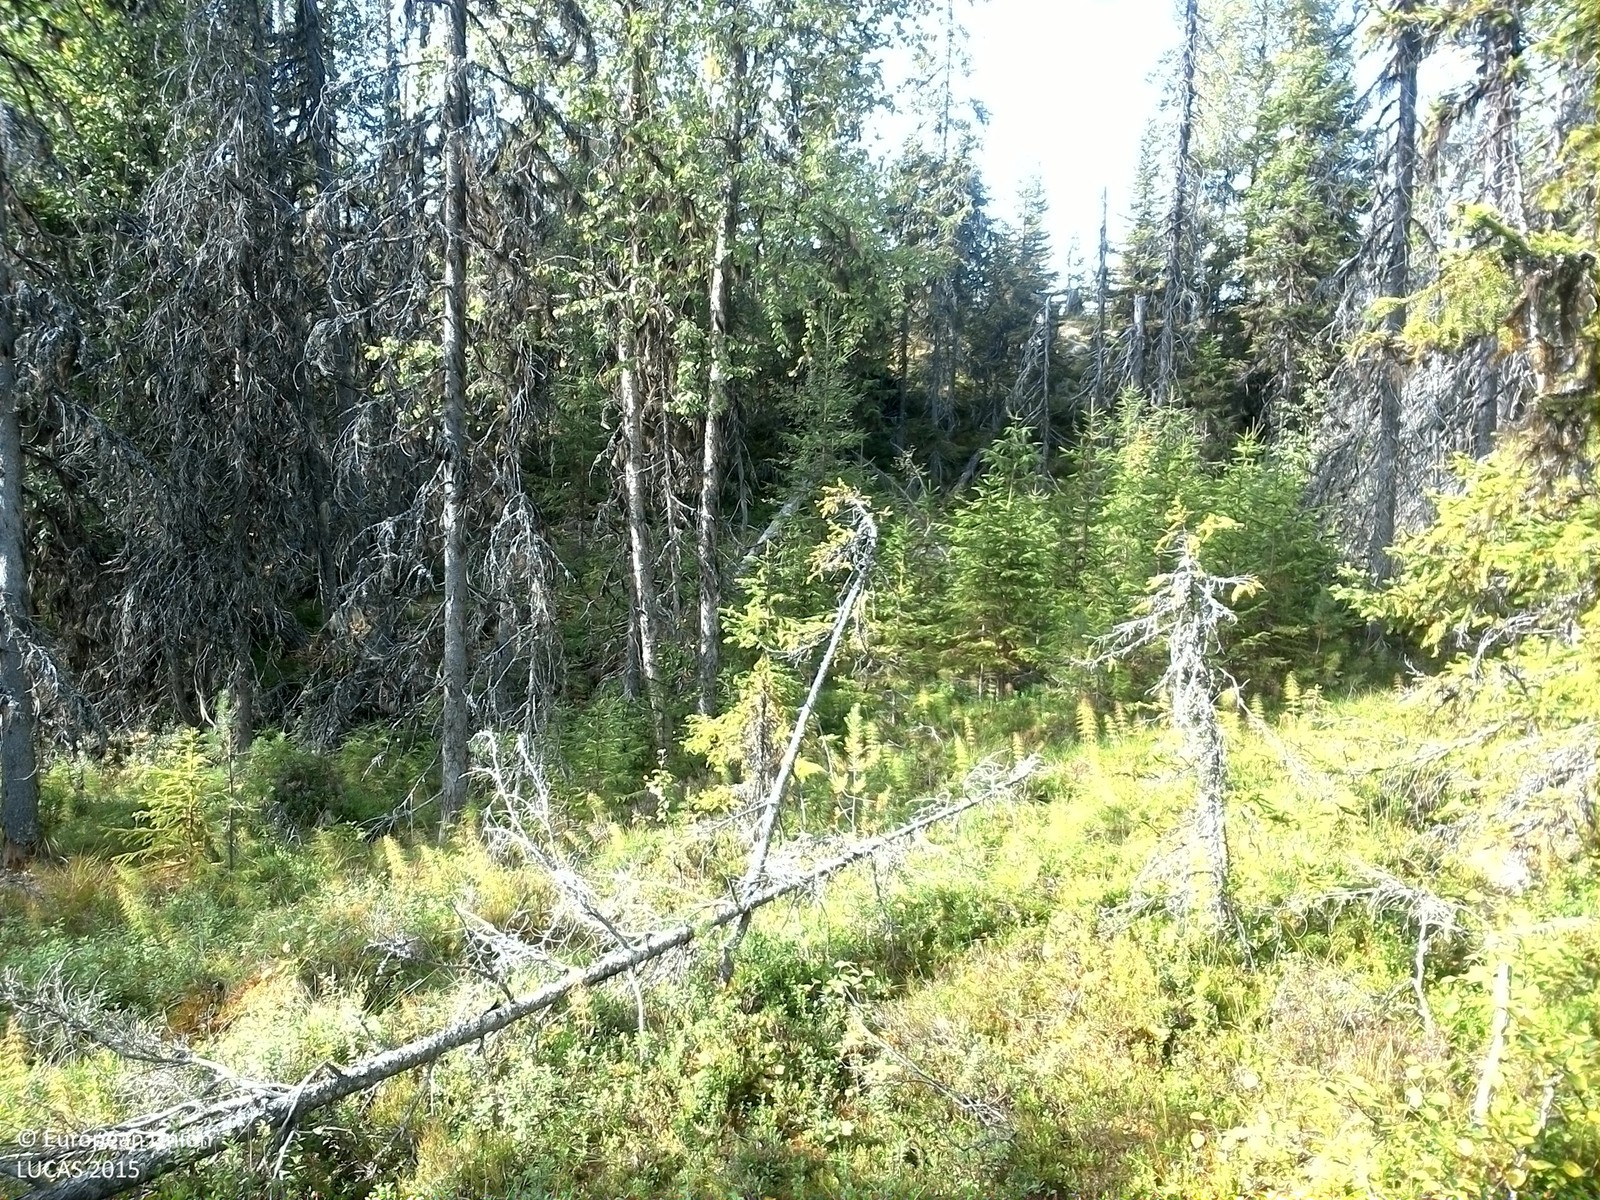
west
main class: Woodland
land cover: Spruce dominated mixed woodland
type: boreal forest
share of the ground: 25 - 50 %
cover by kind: coniferous forest trees 35 %, shrubs 30 %, lichens and mosses 20 %, broadleaved forest trees 15 %
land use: Forestry
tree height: > 5 m
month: September
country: SE
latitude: 61.7178
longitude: 14.3927
